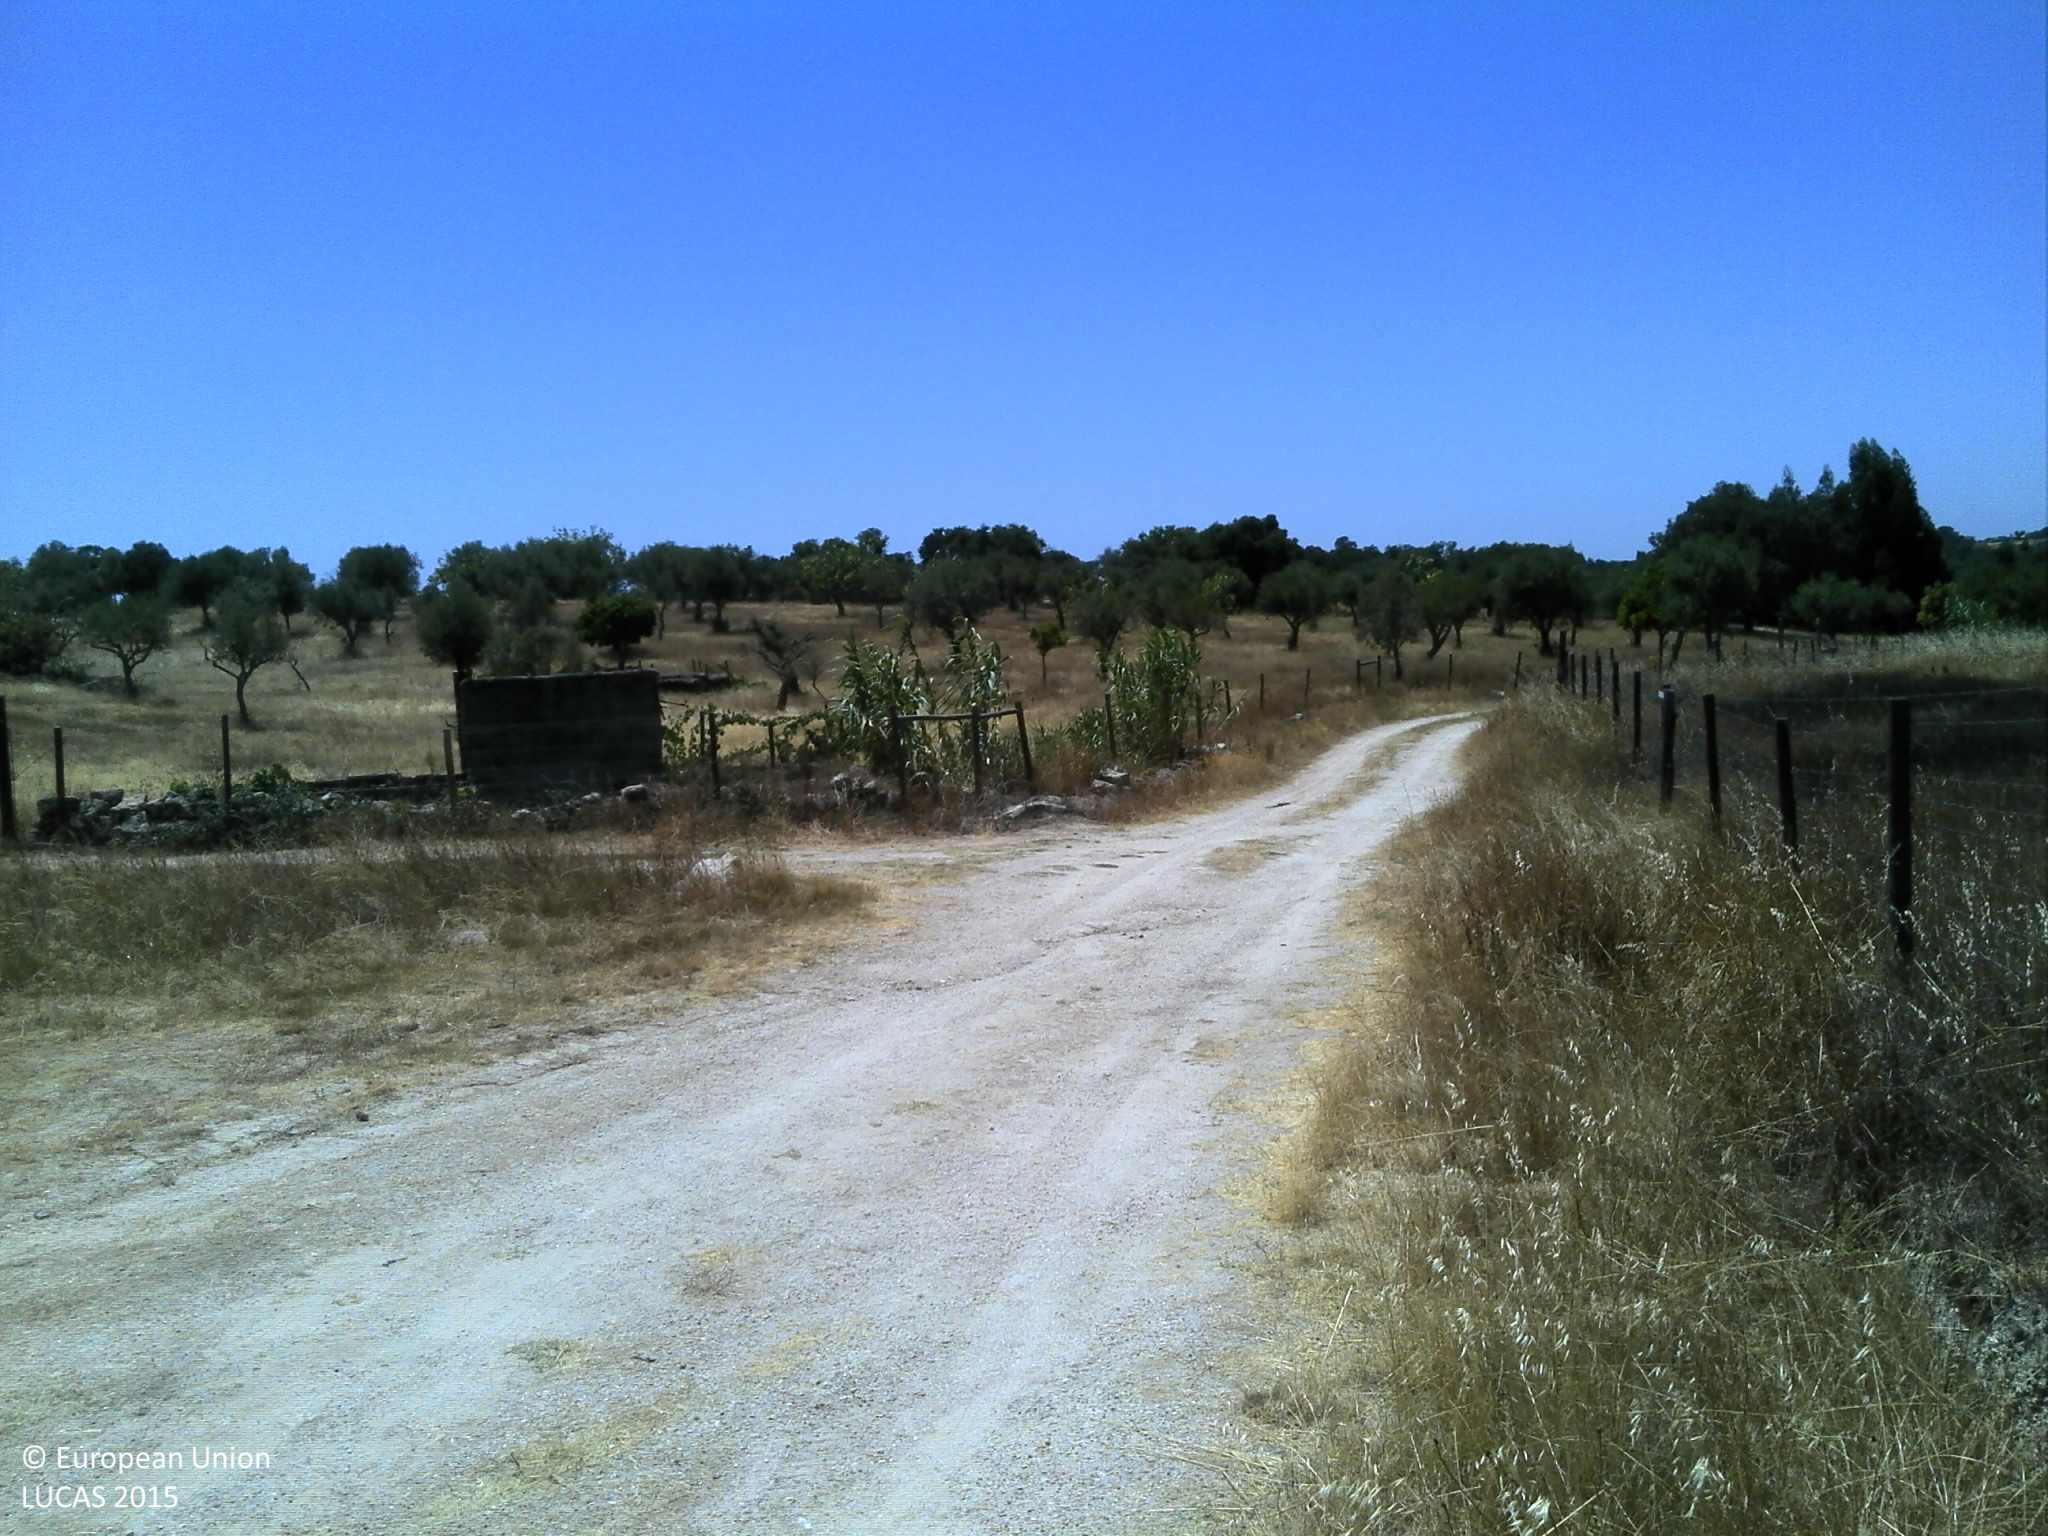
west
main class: Grassland
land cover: Grassland with sparse tree/shrub cover
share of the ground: 10 - 25 %
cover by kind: unconsolidated bare surface 80 %, herbaceous plants 15 %, broadleaved forest trees 5 %
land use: Agriculture (excluding fallow land and kitchen gardens)
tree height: > 5 m
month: July
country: PT
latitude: 39.3241
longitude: -7.7153
